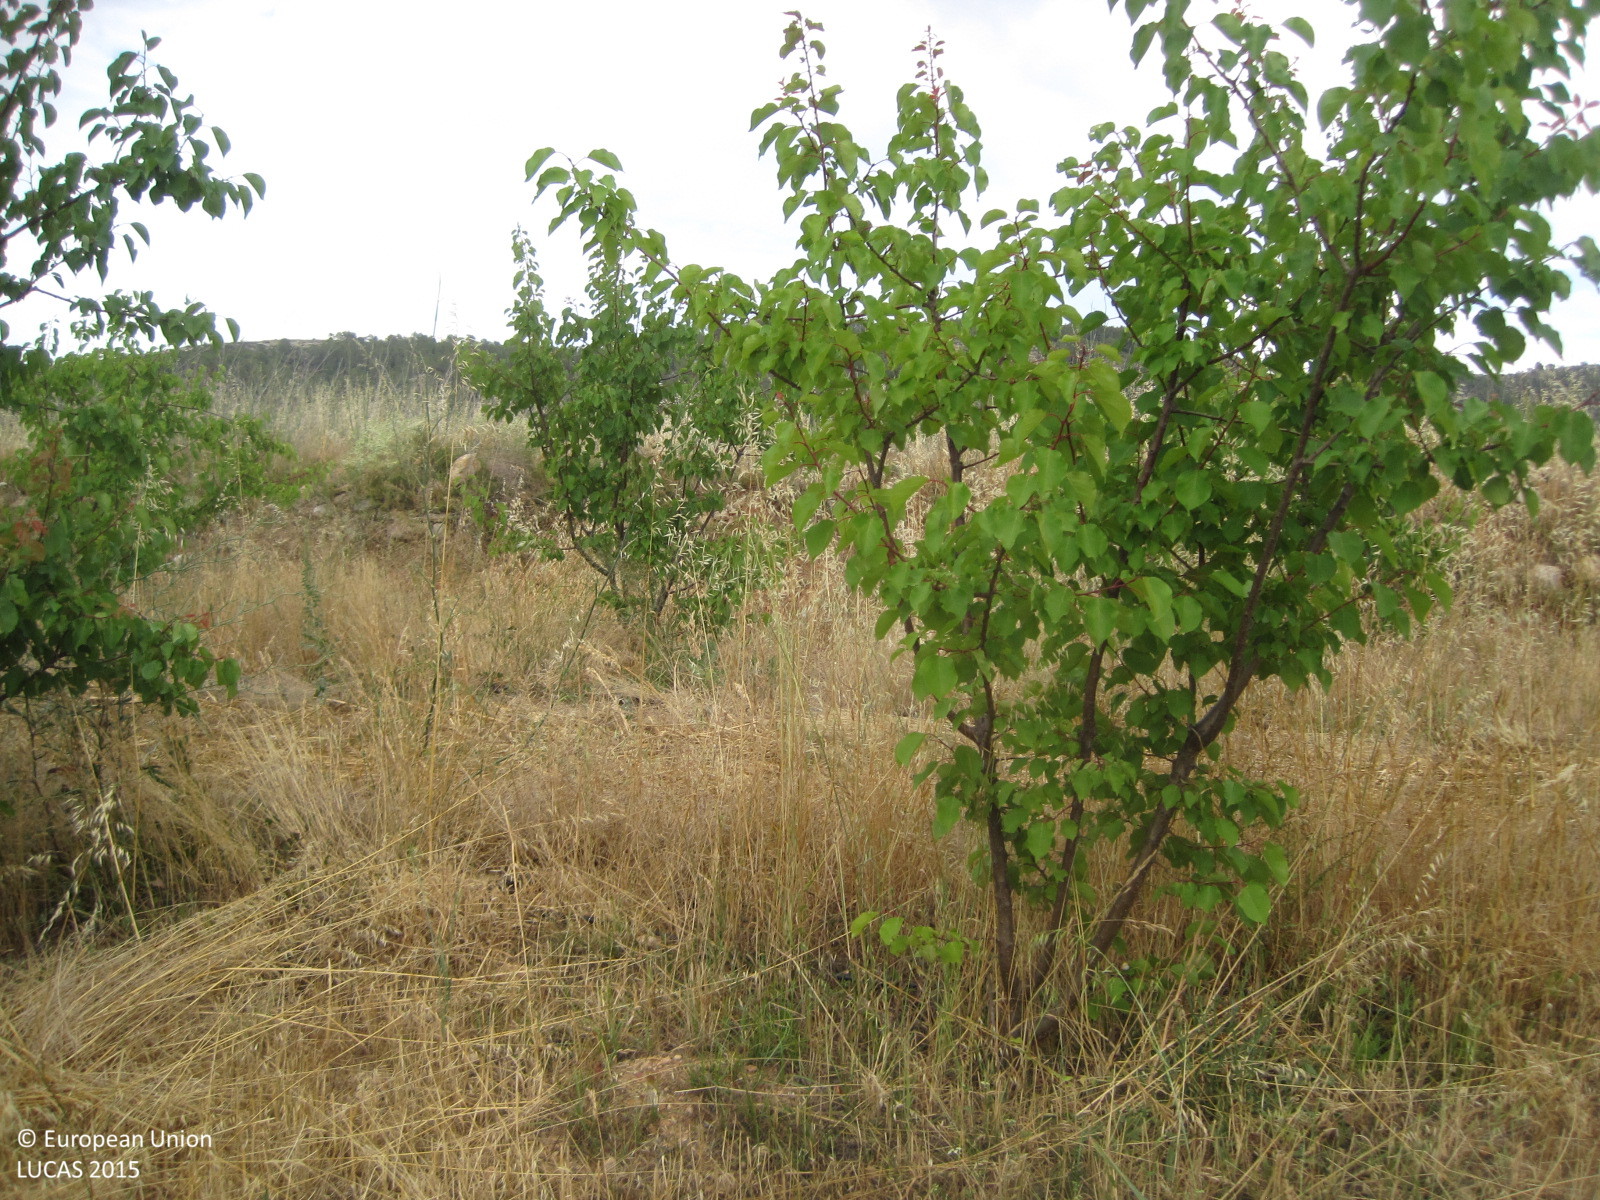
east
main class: Cropland
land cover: Other fruit trees and berries
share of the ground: 10 - 25 %
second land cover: Spontaneously vegetated surfaces
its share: > 75 %
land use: Agriculture (excluding fallow land and kitchen gardens)
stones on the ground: 10 - 25 %
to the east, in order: Other fruit trees and berries; Spontaneously vegetated surfaces; Tracks; Other fruit trees and berries; Grassland without tree/shrub cover; Dry stone walls; Grass margins; Other citrus fruit; Grassland without tree/shrub cover
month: June
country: ES
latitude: 39.3075
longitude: -0.6079
